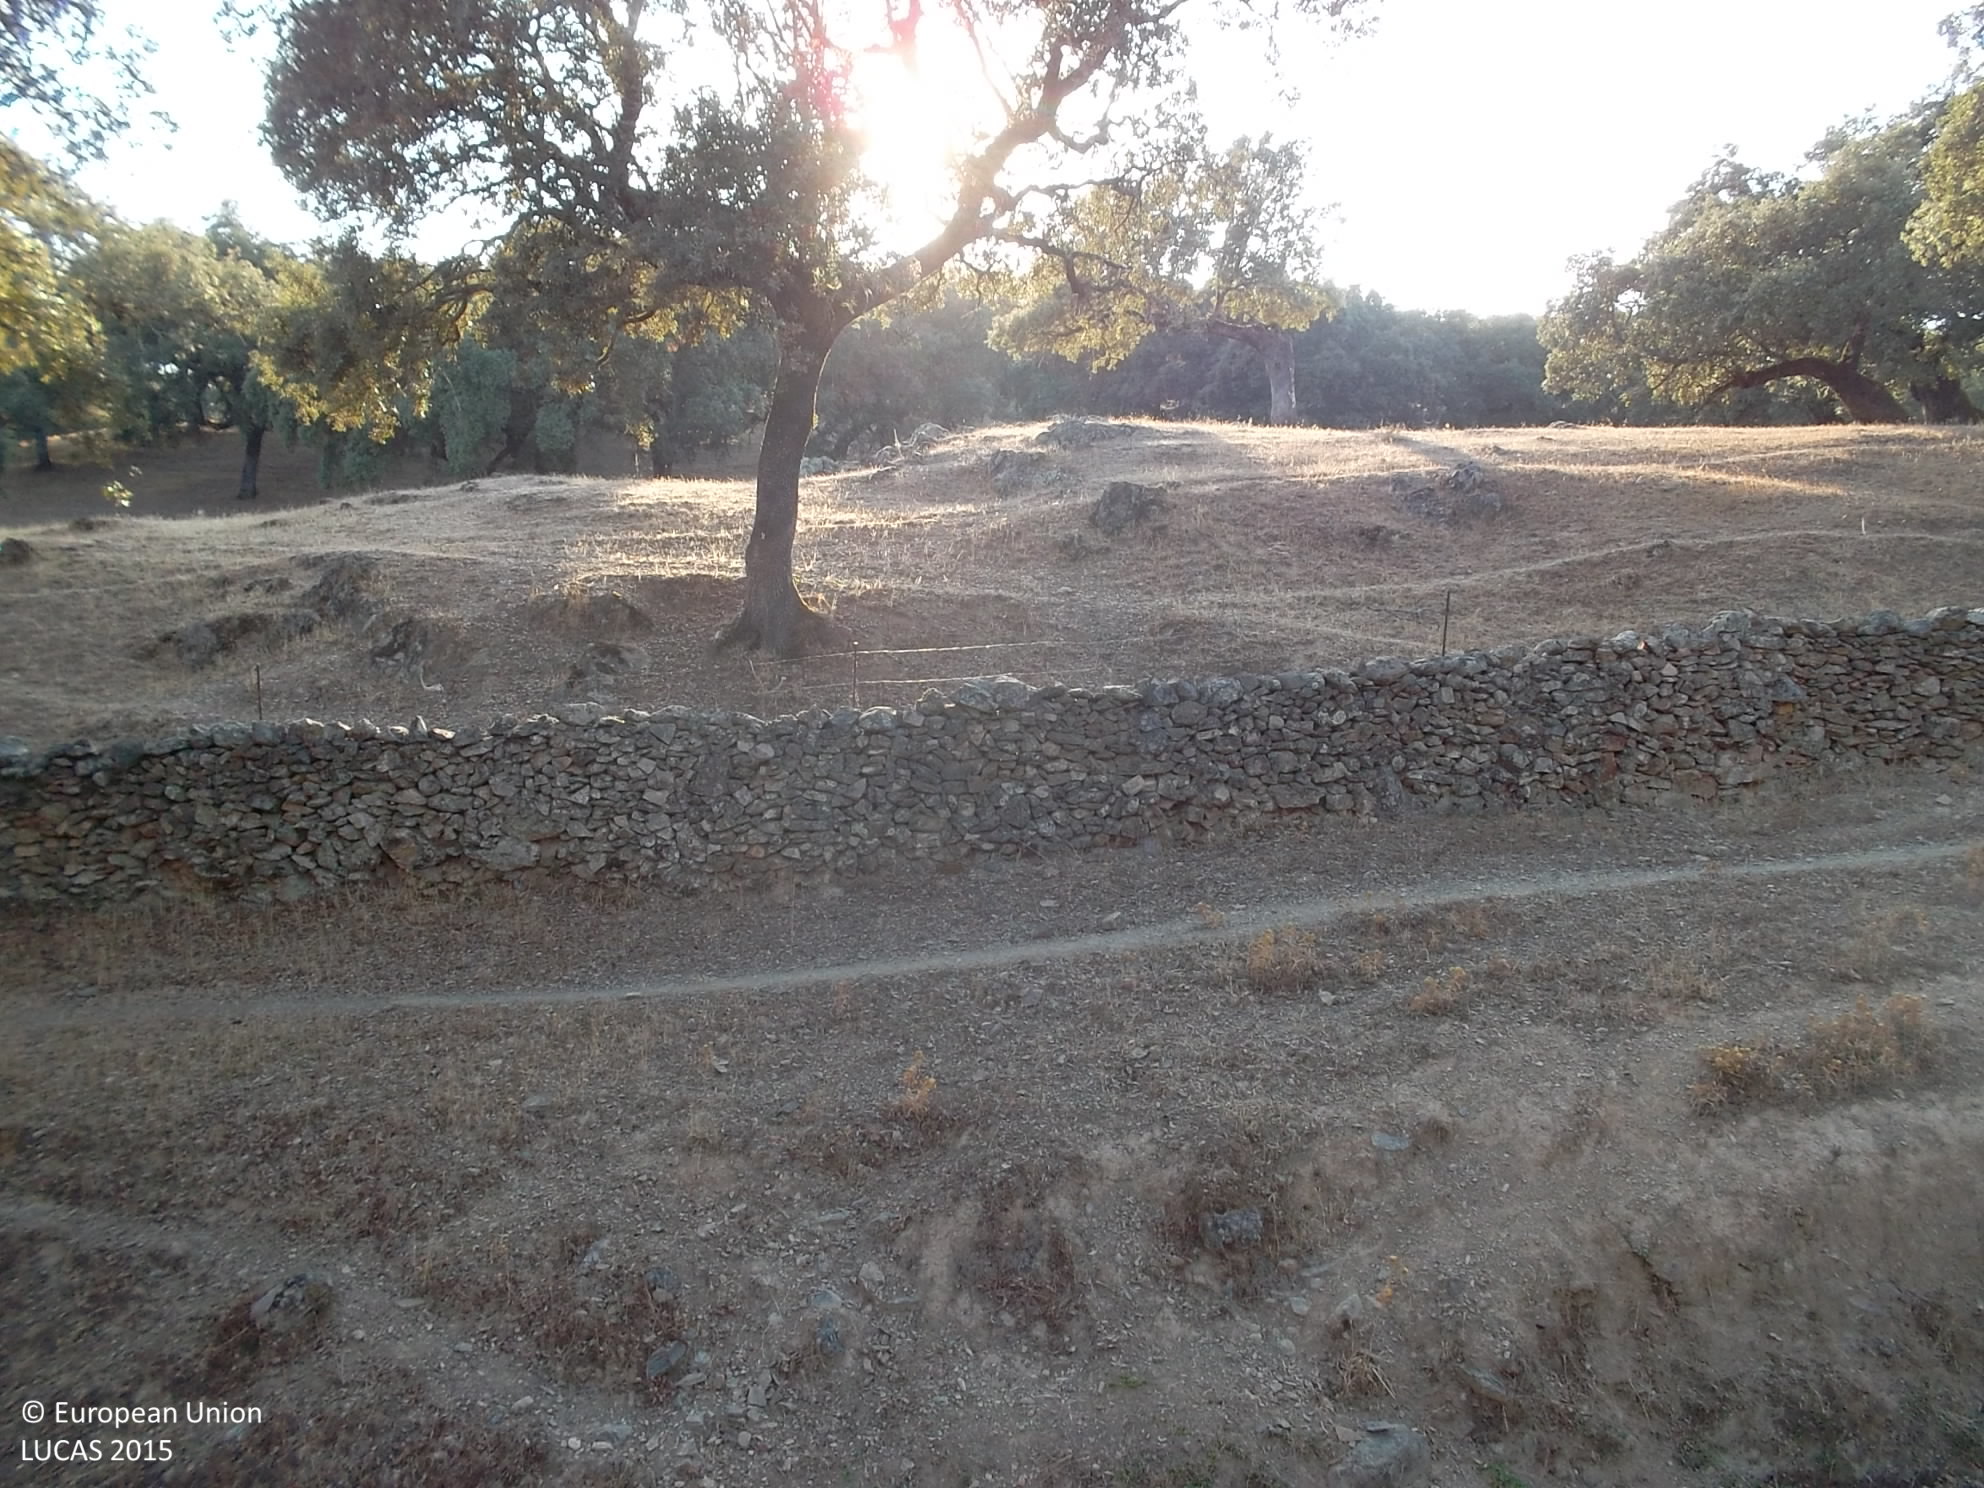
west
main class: Woodland
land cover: Broadleaved woodland
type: broadleaved evergreen forest
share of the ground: 10 - 25 %
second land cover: Grassland without tree/shrub cover
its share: > 75 %
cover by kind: herbaceous plants 80 %, broadleaved forest trees 20 %
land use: Forestry
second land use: Agriculture (excluding fallow land and kitchen gardens)
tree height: > 5 m
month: September
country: ES
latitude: 38.0425
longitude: -6.5335
